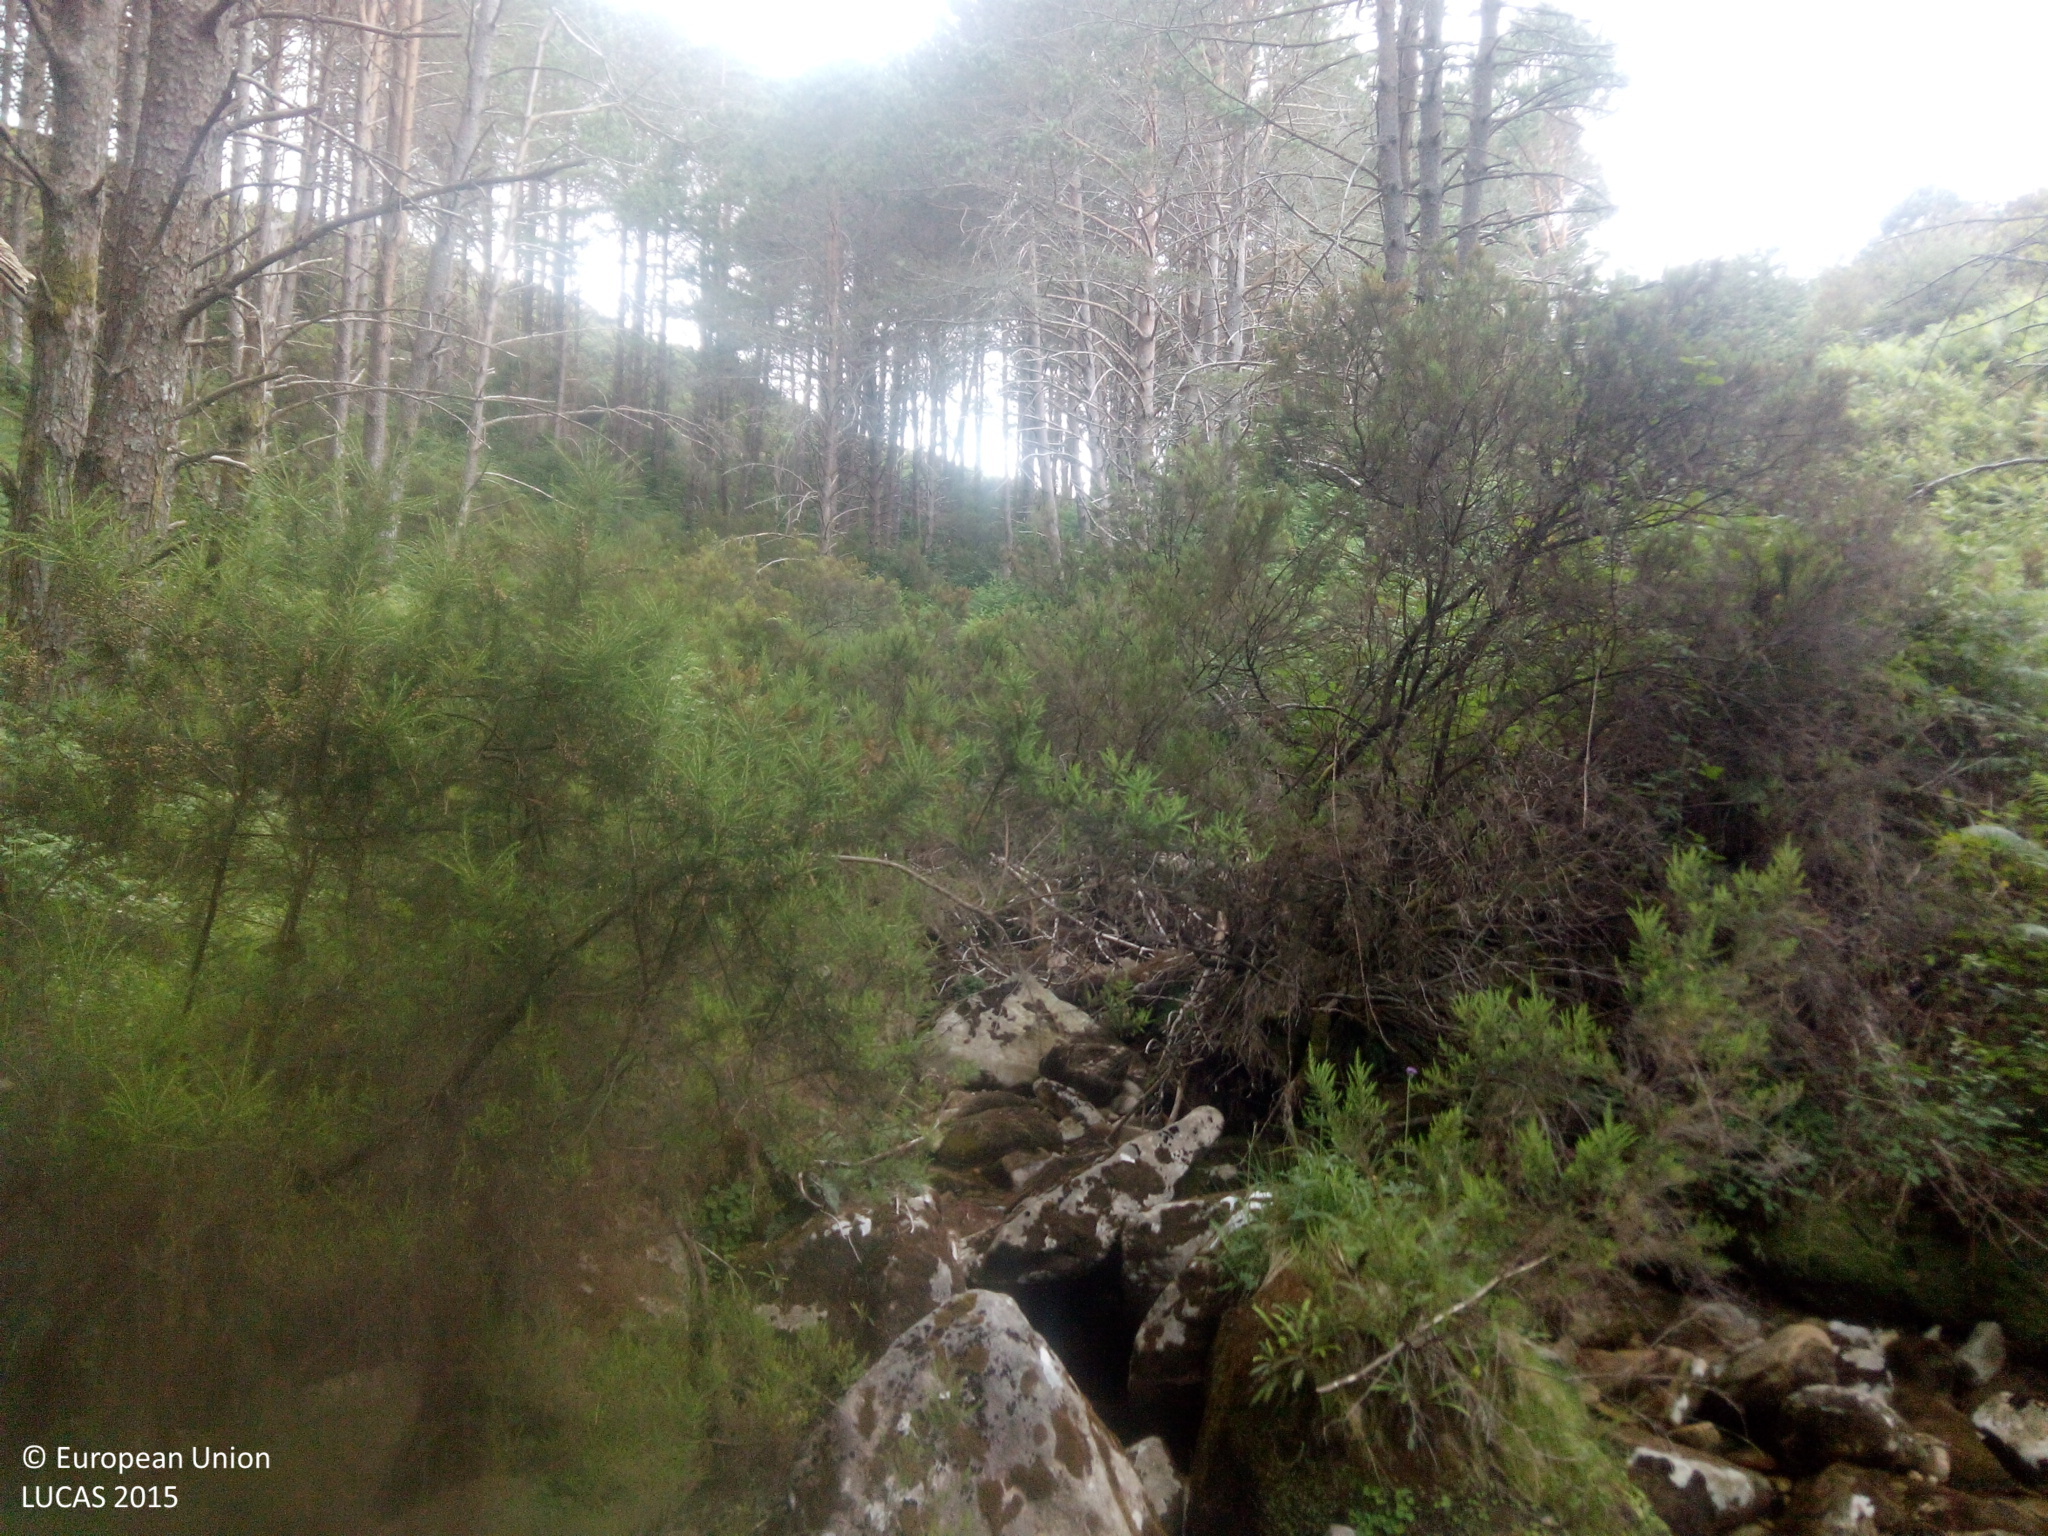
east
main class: Woodland
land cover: Pine dominated coniferous woodland
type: exotic forest
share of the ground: > 75 %
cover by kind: coniferous forest trees 100 %
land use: Forestry
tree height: > 5 m
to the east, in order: Pine dominated coniferous woodland; Grassland with sparse tree/shrub cover; Tracks; Shrubland without tree cover; Rock outcrops; Shrubland without tree cover; Grassland with sparse tree/shrub cover; Rock outcrops; Shrubland with sparse tree cover; Ditches and canals; Paved roads, cycling and walking lanes; Ditches and canals; Grassland with sparse tree/shrub cover
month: July
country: ES
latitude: 42.3091
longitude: -8.2490
